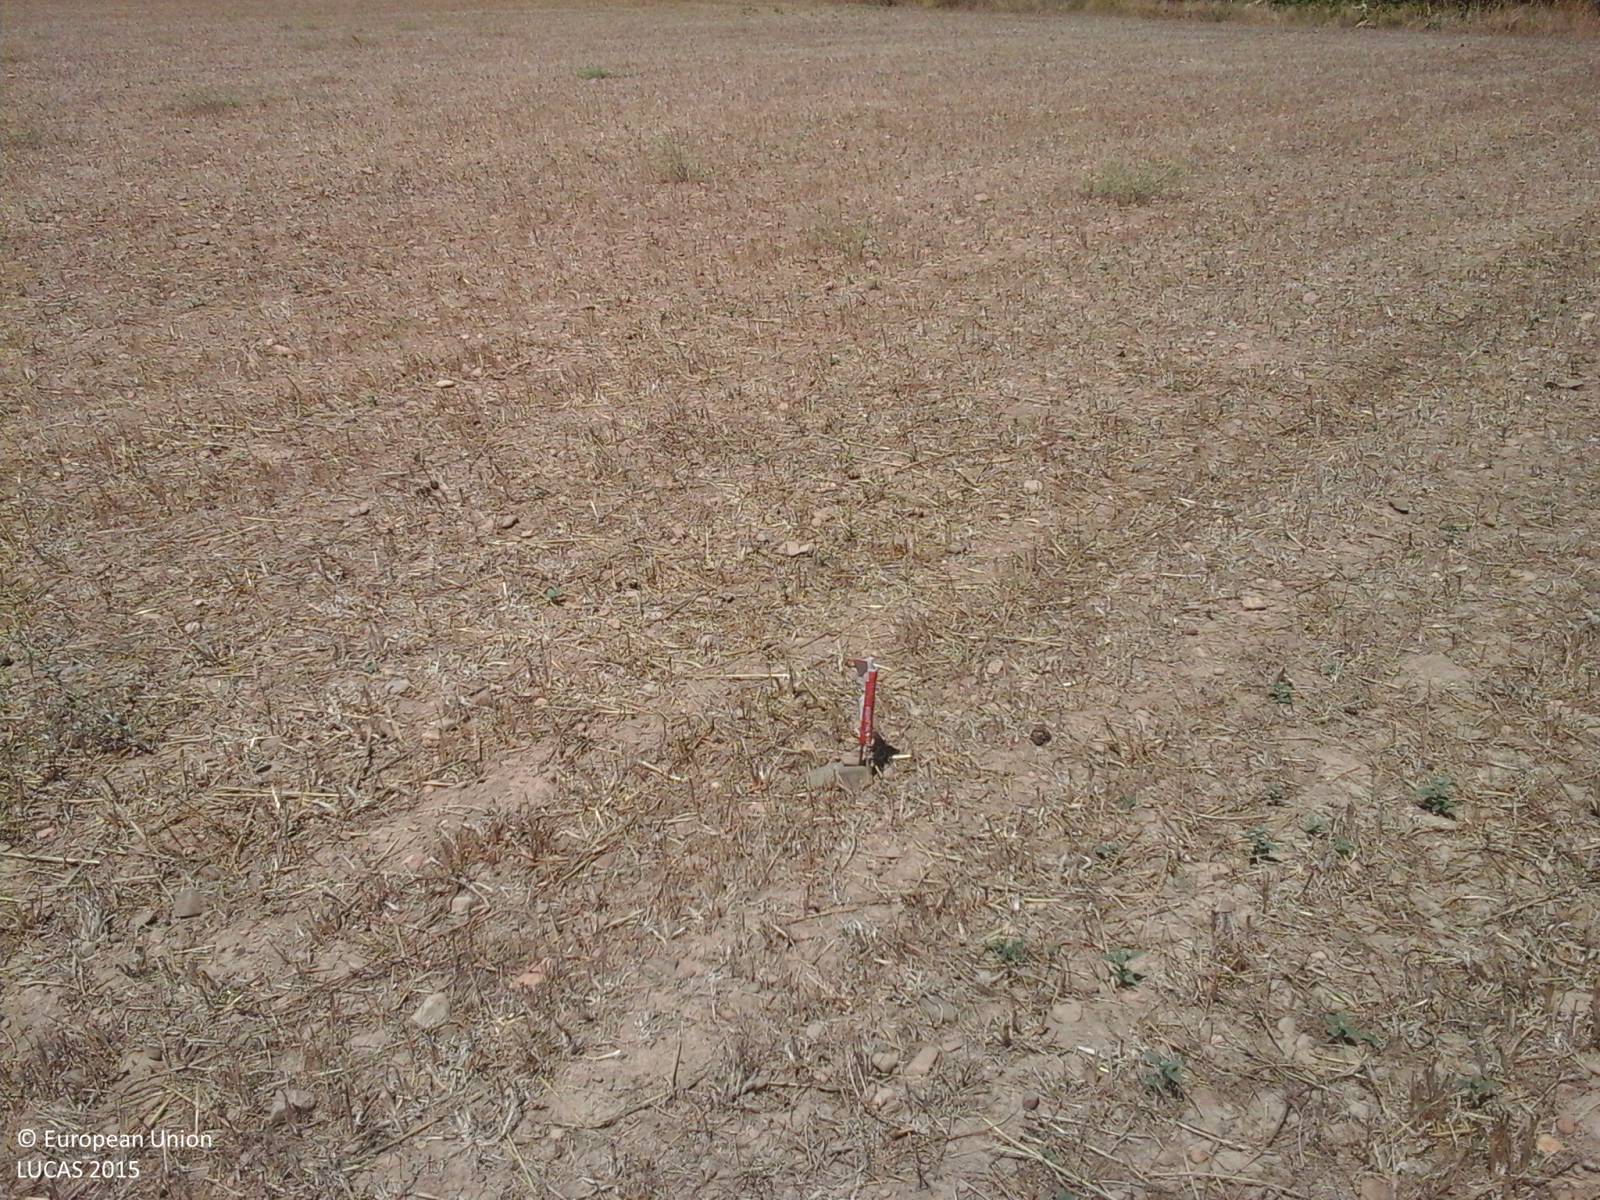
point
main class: Cropland
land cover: Mixed cereals for fodder
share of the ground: > 75 %
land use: Agriculture (excluding fallow land and kitchen gardens)
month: August
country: IT
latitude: 39.3737
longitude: 8.9039
